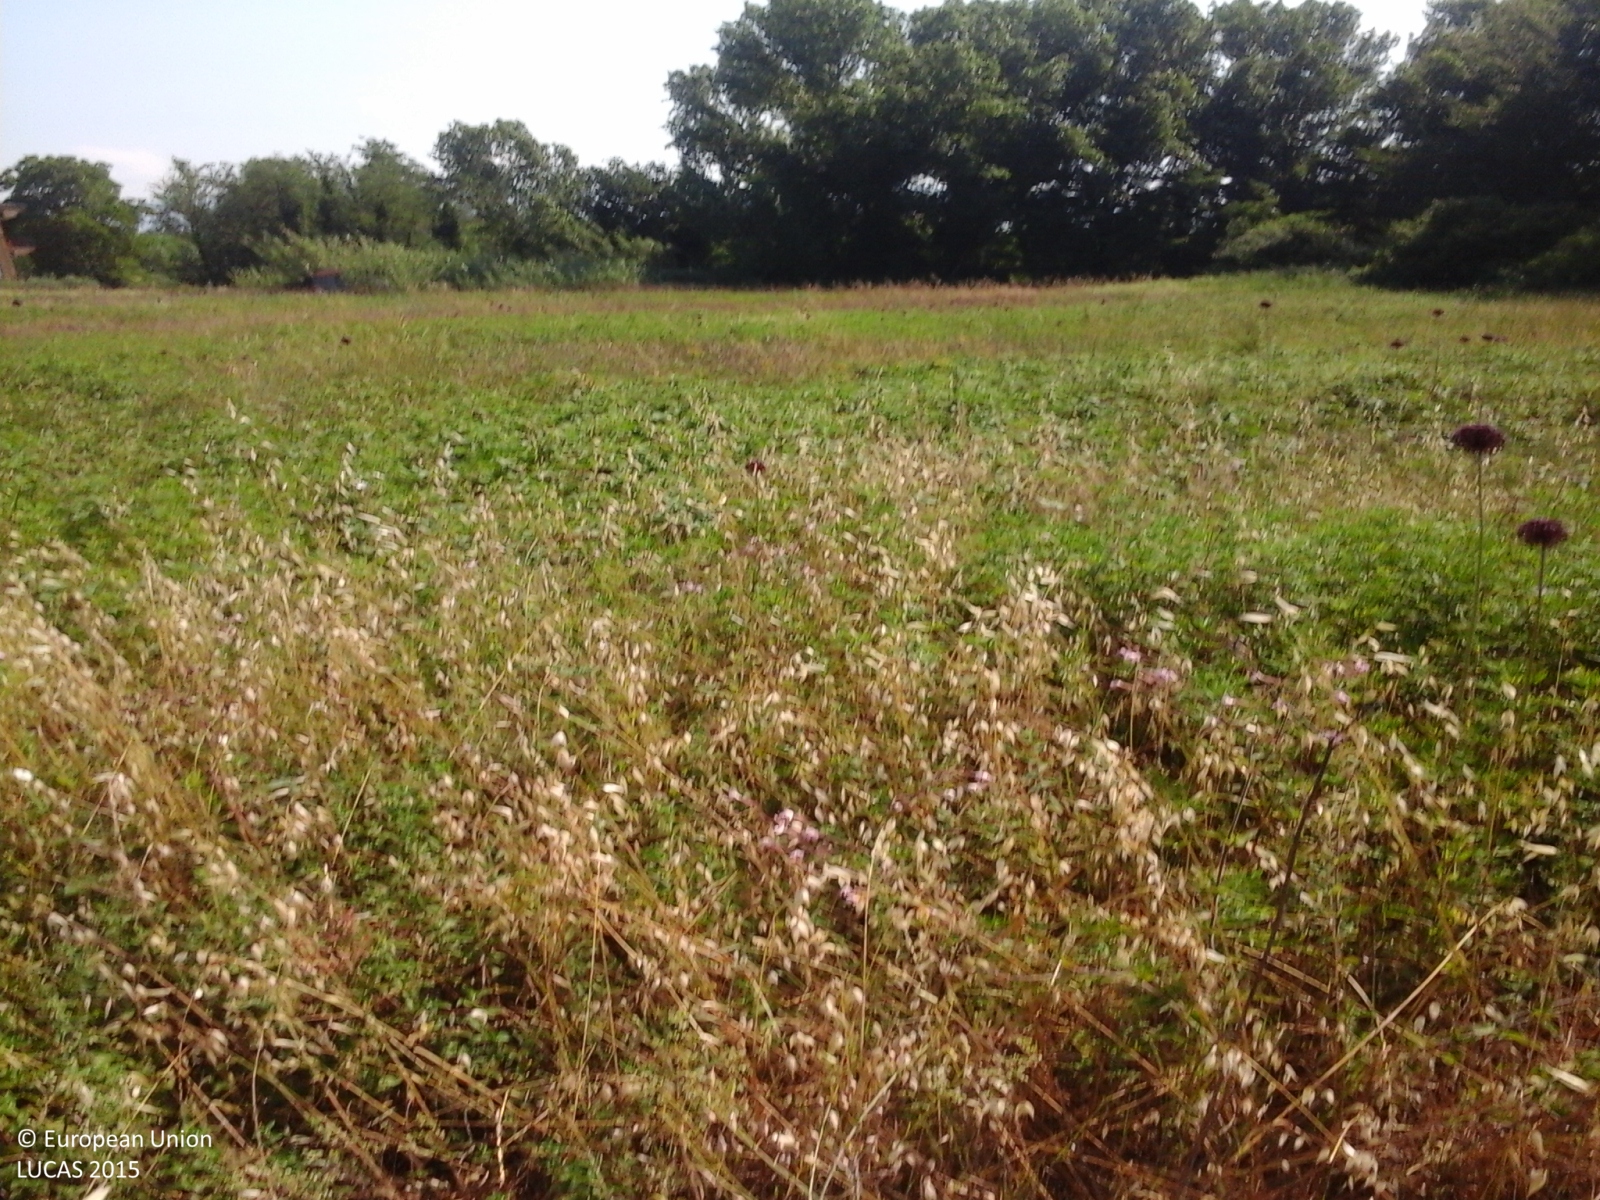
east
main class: Grassland
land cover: Grassland without tree/shrub cover
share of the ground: > 75 %
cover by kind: herbaceous plants 100 %
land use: Agriculture (excluding fallow land and kitchen gardens)
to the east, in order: Grassland without tree/shrub cover; Shrubland with sparse tree cover; Broadleaved woodland; Potatoes; Tomatoes; Other fresh vegetables; Artificial constructions in urban areas; Grassland without tree/shrub cover; Fences; Grassland without tree/shrub cover; Artificial constructions in urban areas
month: May
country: IT
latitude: 41.6407
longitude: 13.3369
